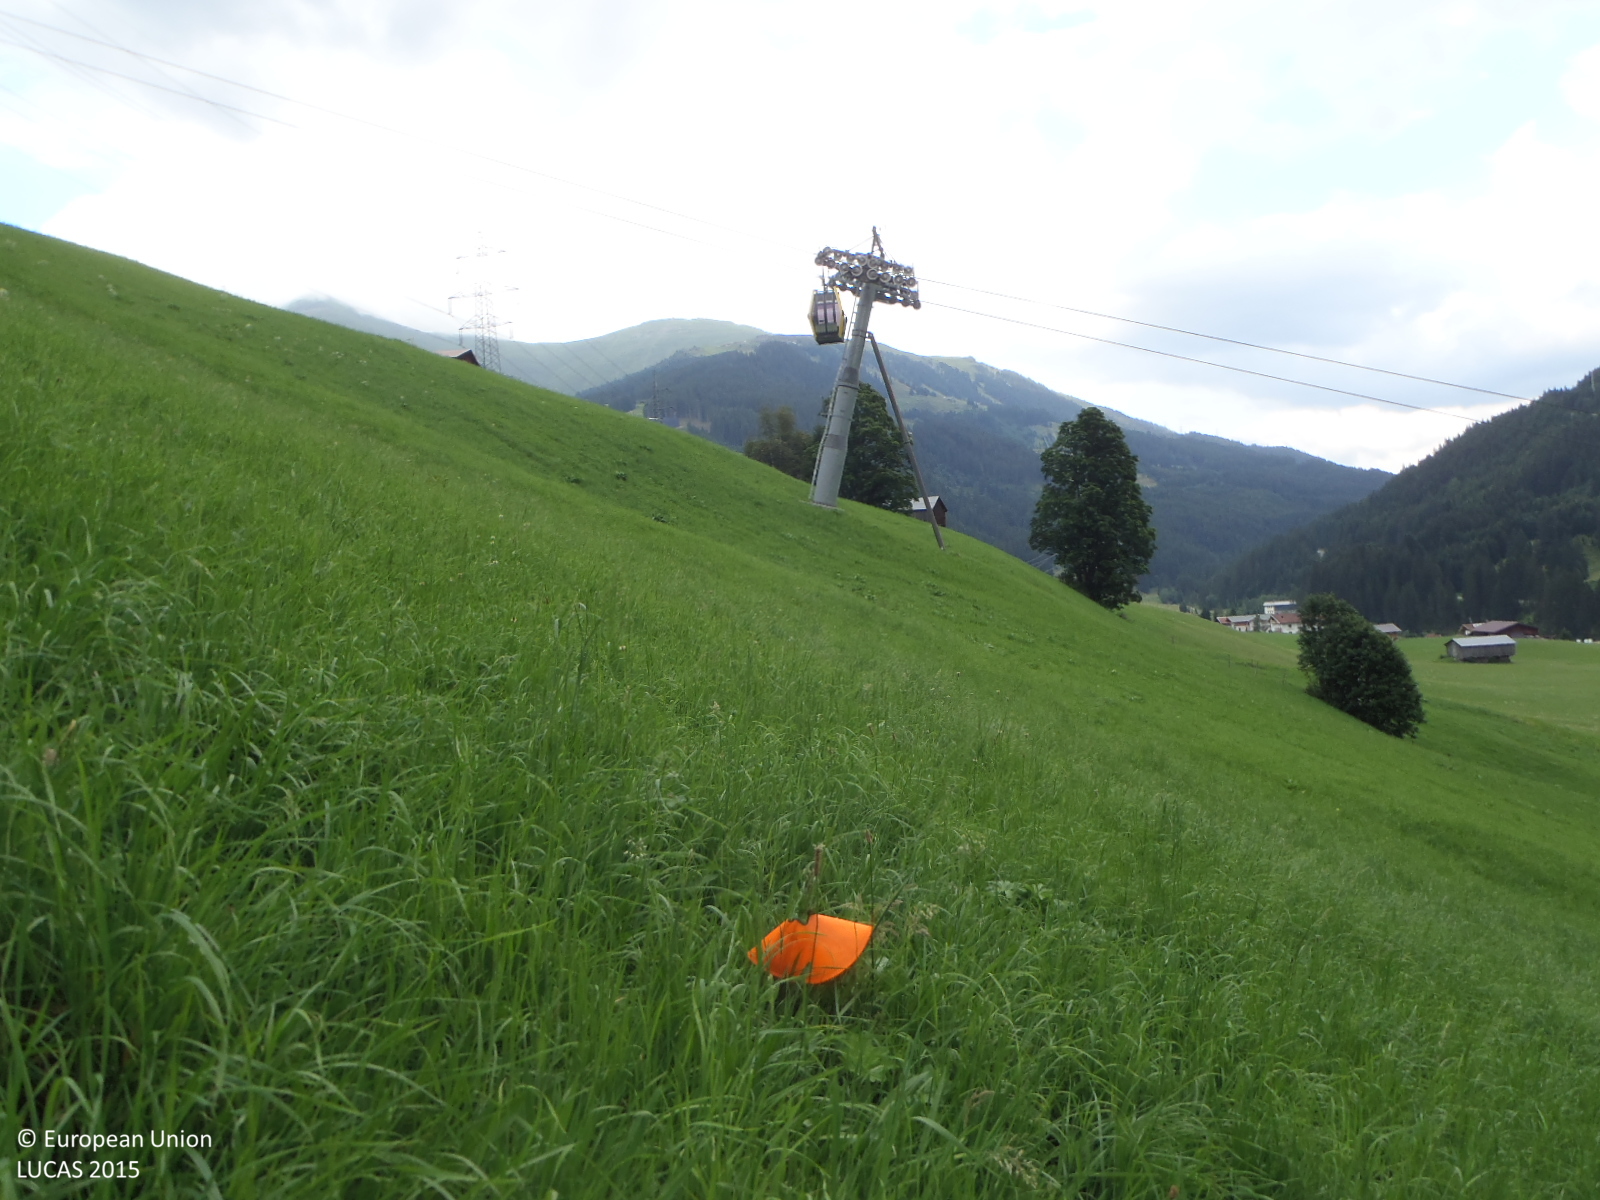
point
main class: Grassland
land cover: Grassland without tree/shrub cover
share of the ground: > 75 %
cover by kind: herbaceous plants 100 %
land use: Agriculture (excluding fallow land and kitchen gardens)
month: July
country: AT
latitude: 47.2323
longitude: 12.0456
